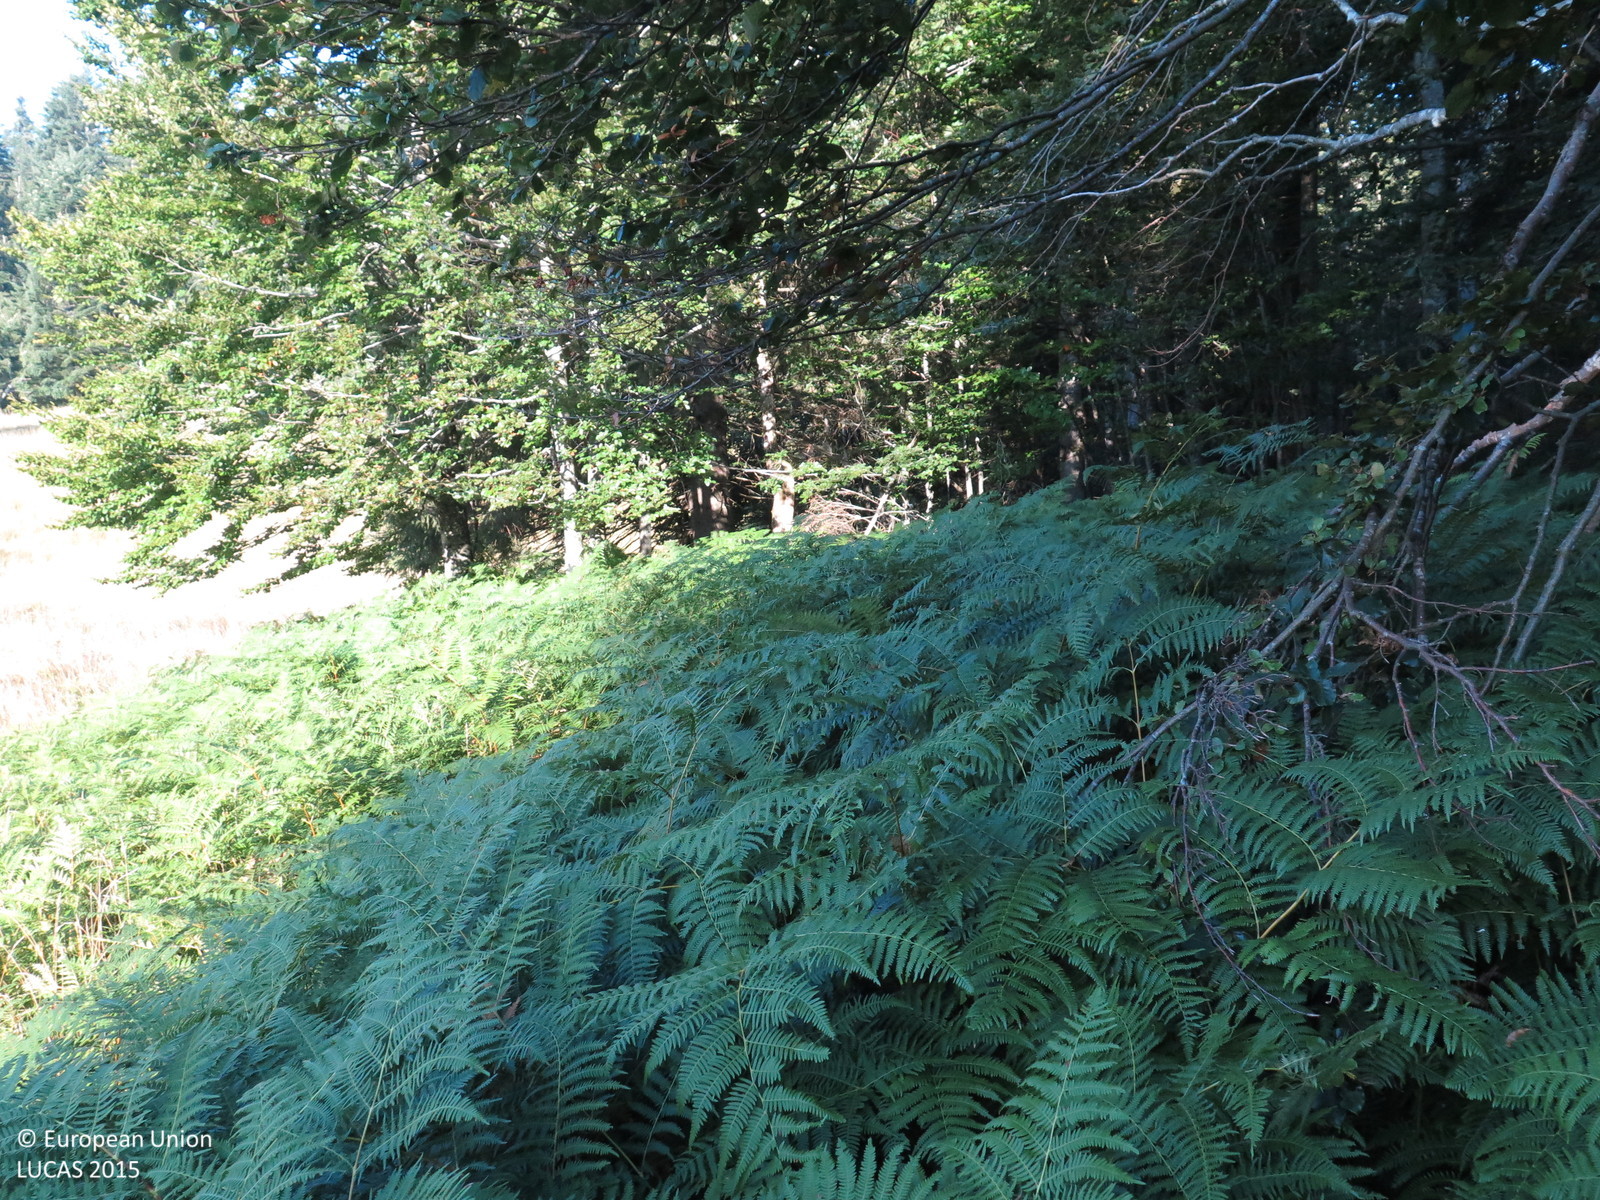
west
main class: Woodland
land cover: Other mixed woodland
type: mountainous beech forest
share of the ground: > 75 %
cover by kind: coniferous forest trees 75 %, broadleaved forest trees 25 %
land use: Forestry
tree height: > 5 m
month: September
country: HR
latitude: 45.5118
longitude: 14.6163
